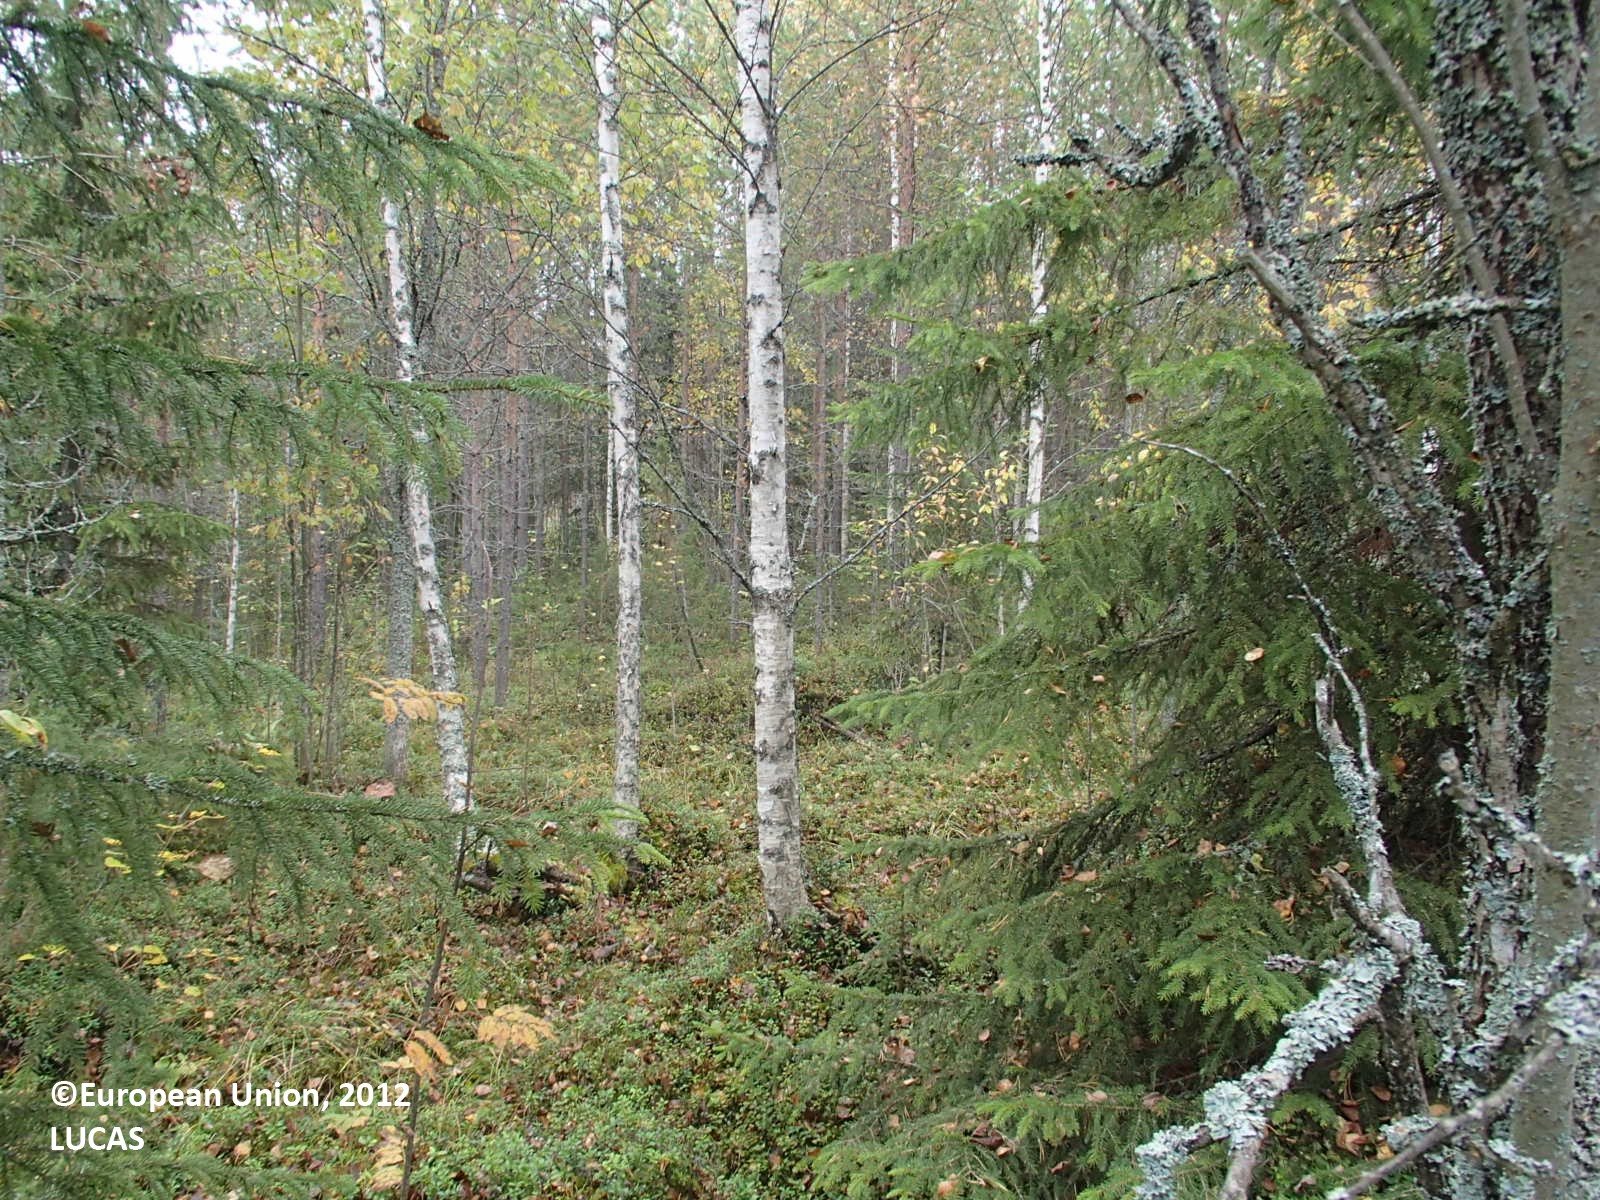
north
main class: Woodland
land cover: Spruce dominated mixed woodland
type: boreal forest
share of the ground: 50 - 75 %
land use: Forestry
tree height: > 5 m
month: September
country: FI
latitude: 63.8685
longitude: 26.9231
